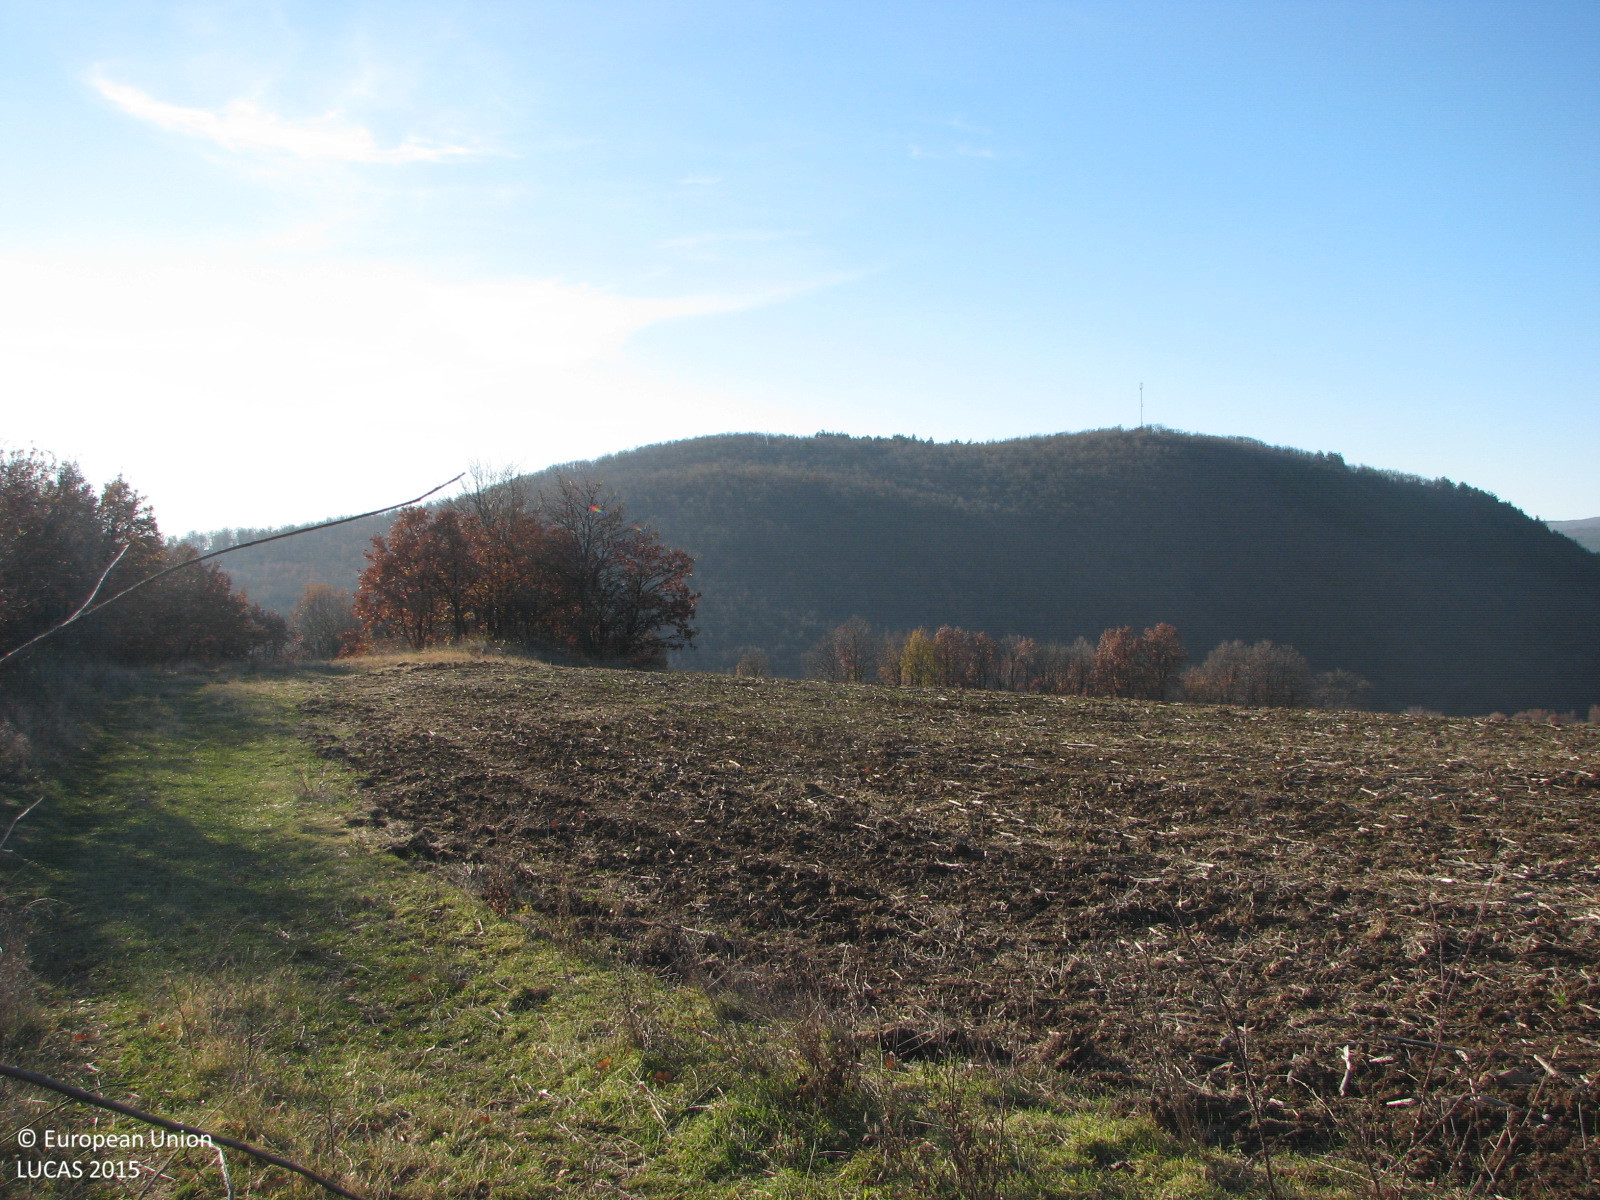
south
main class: Shrubland
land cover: Shrubland with sparse tree cover
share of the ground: 50 - 75 %
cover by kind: shrubs 60 %, herbaceous plants 35 %, broadleaved forest trees 5 %
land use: Semi-natural and natural areas not in use
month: December
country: BG
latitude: 42.4449
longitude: 24.2588
